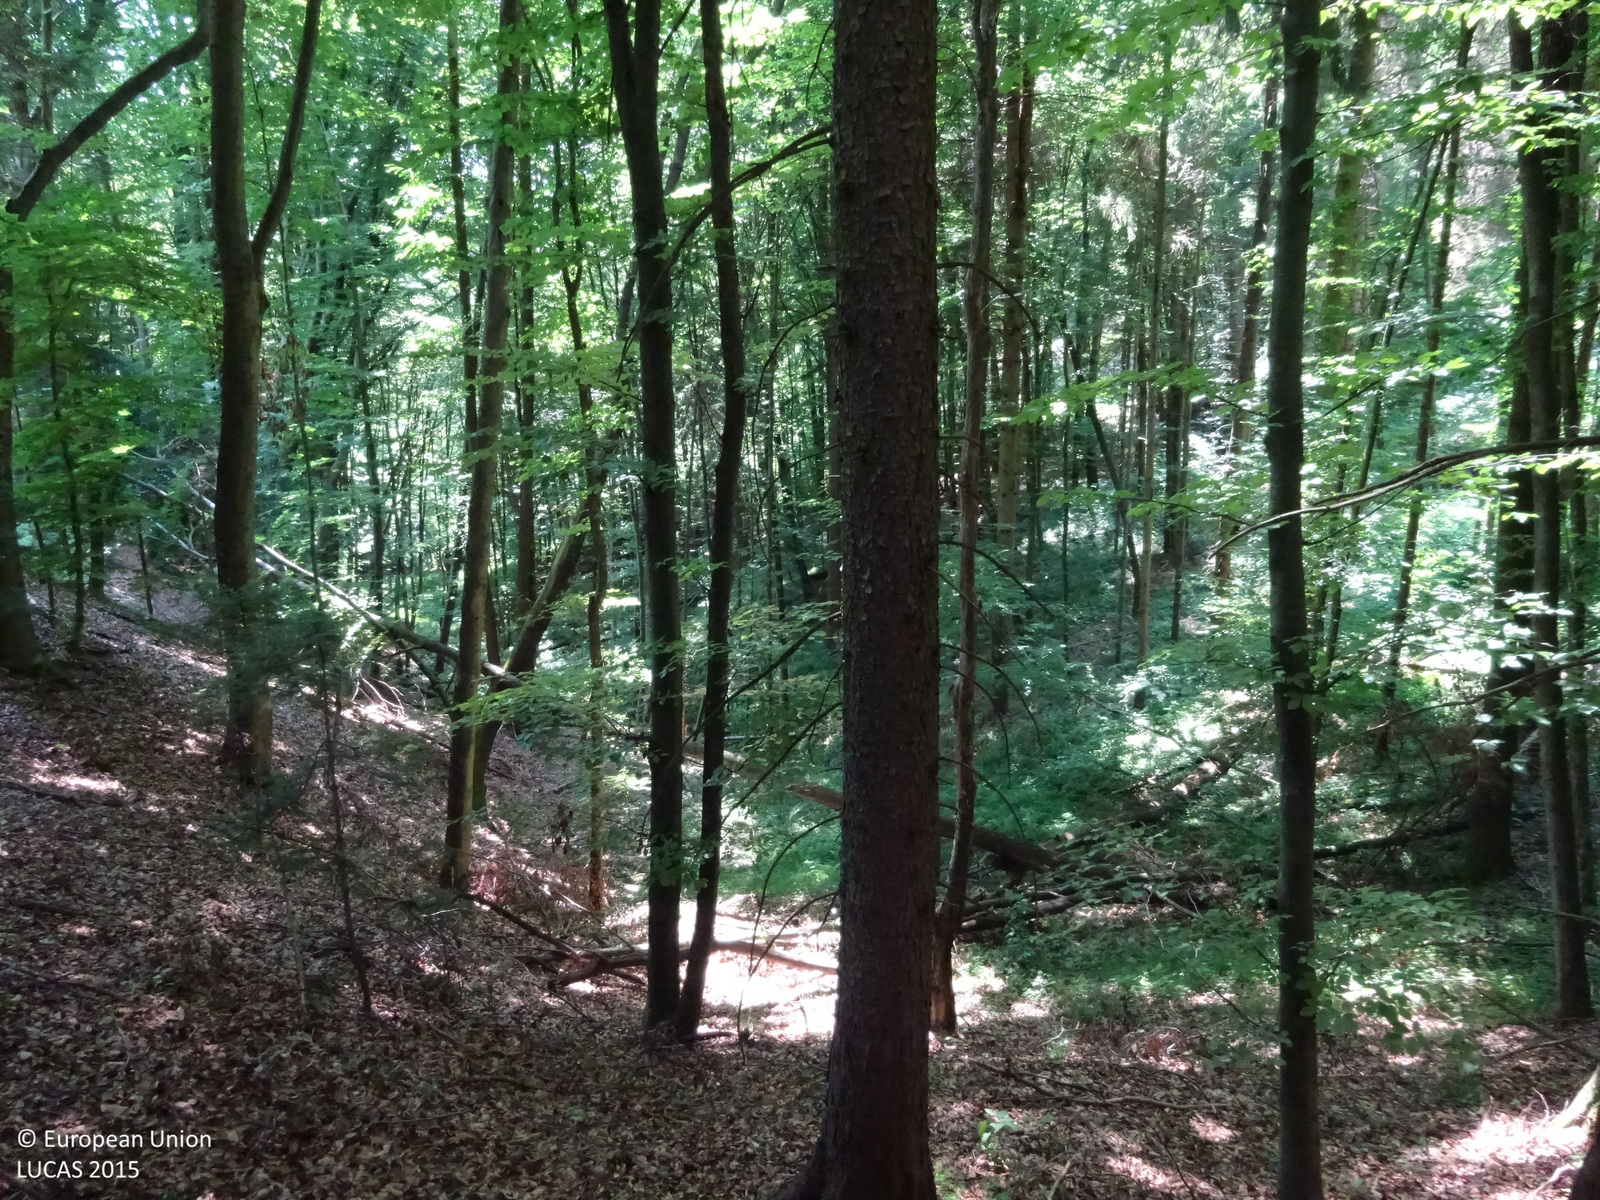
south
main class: Woodland
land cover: Broadleaved woodland
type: mountainous beech forest
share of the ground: > 75 %
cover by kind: broadleaved forest trees 95 %, coniferous forest trees 5 %
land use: Forestry
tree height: > 5 m
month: July
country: AT
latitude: 46.9006
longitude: 16.0787
